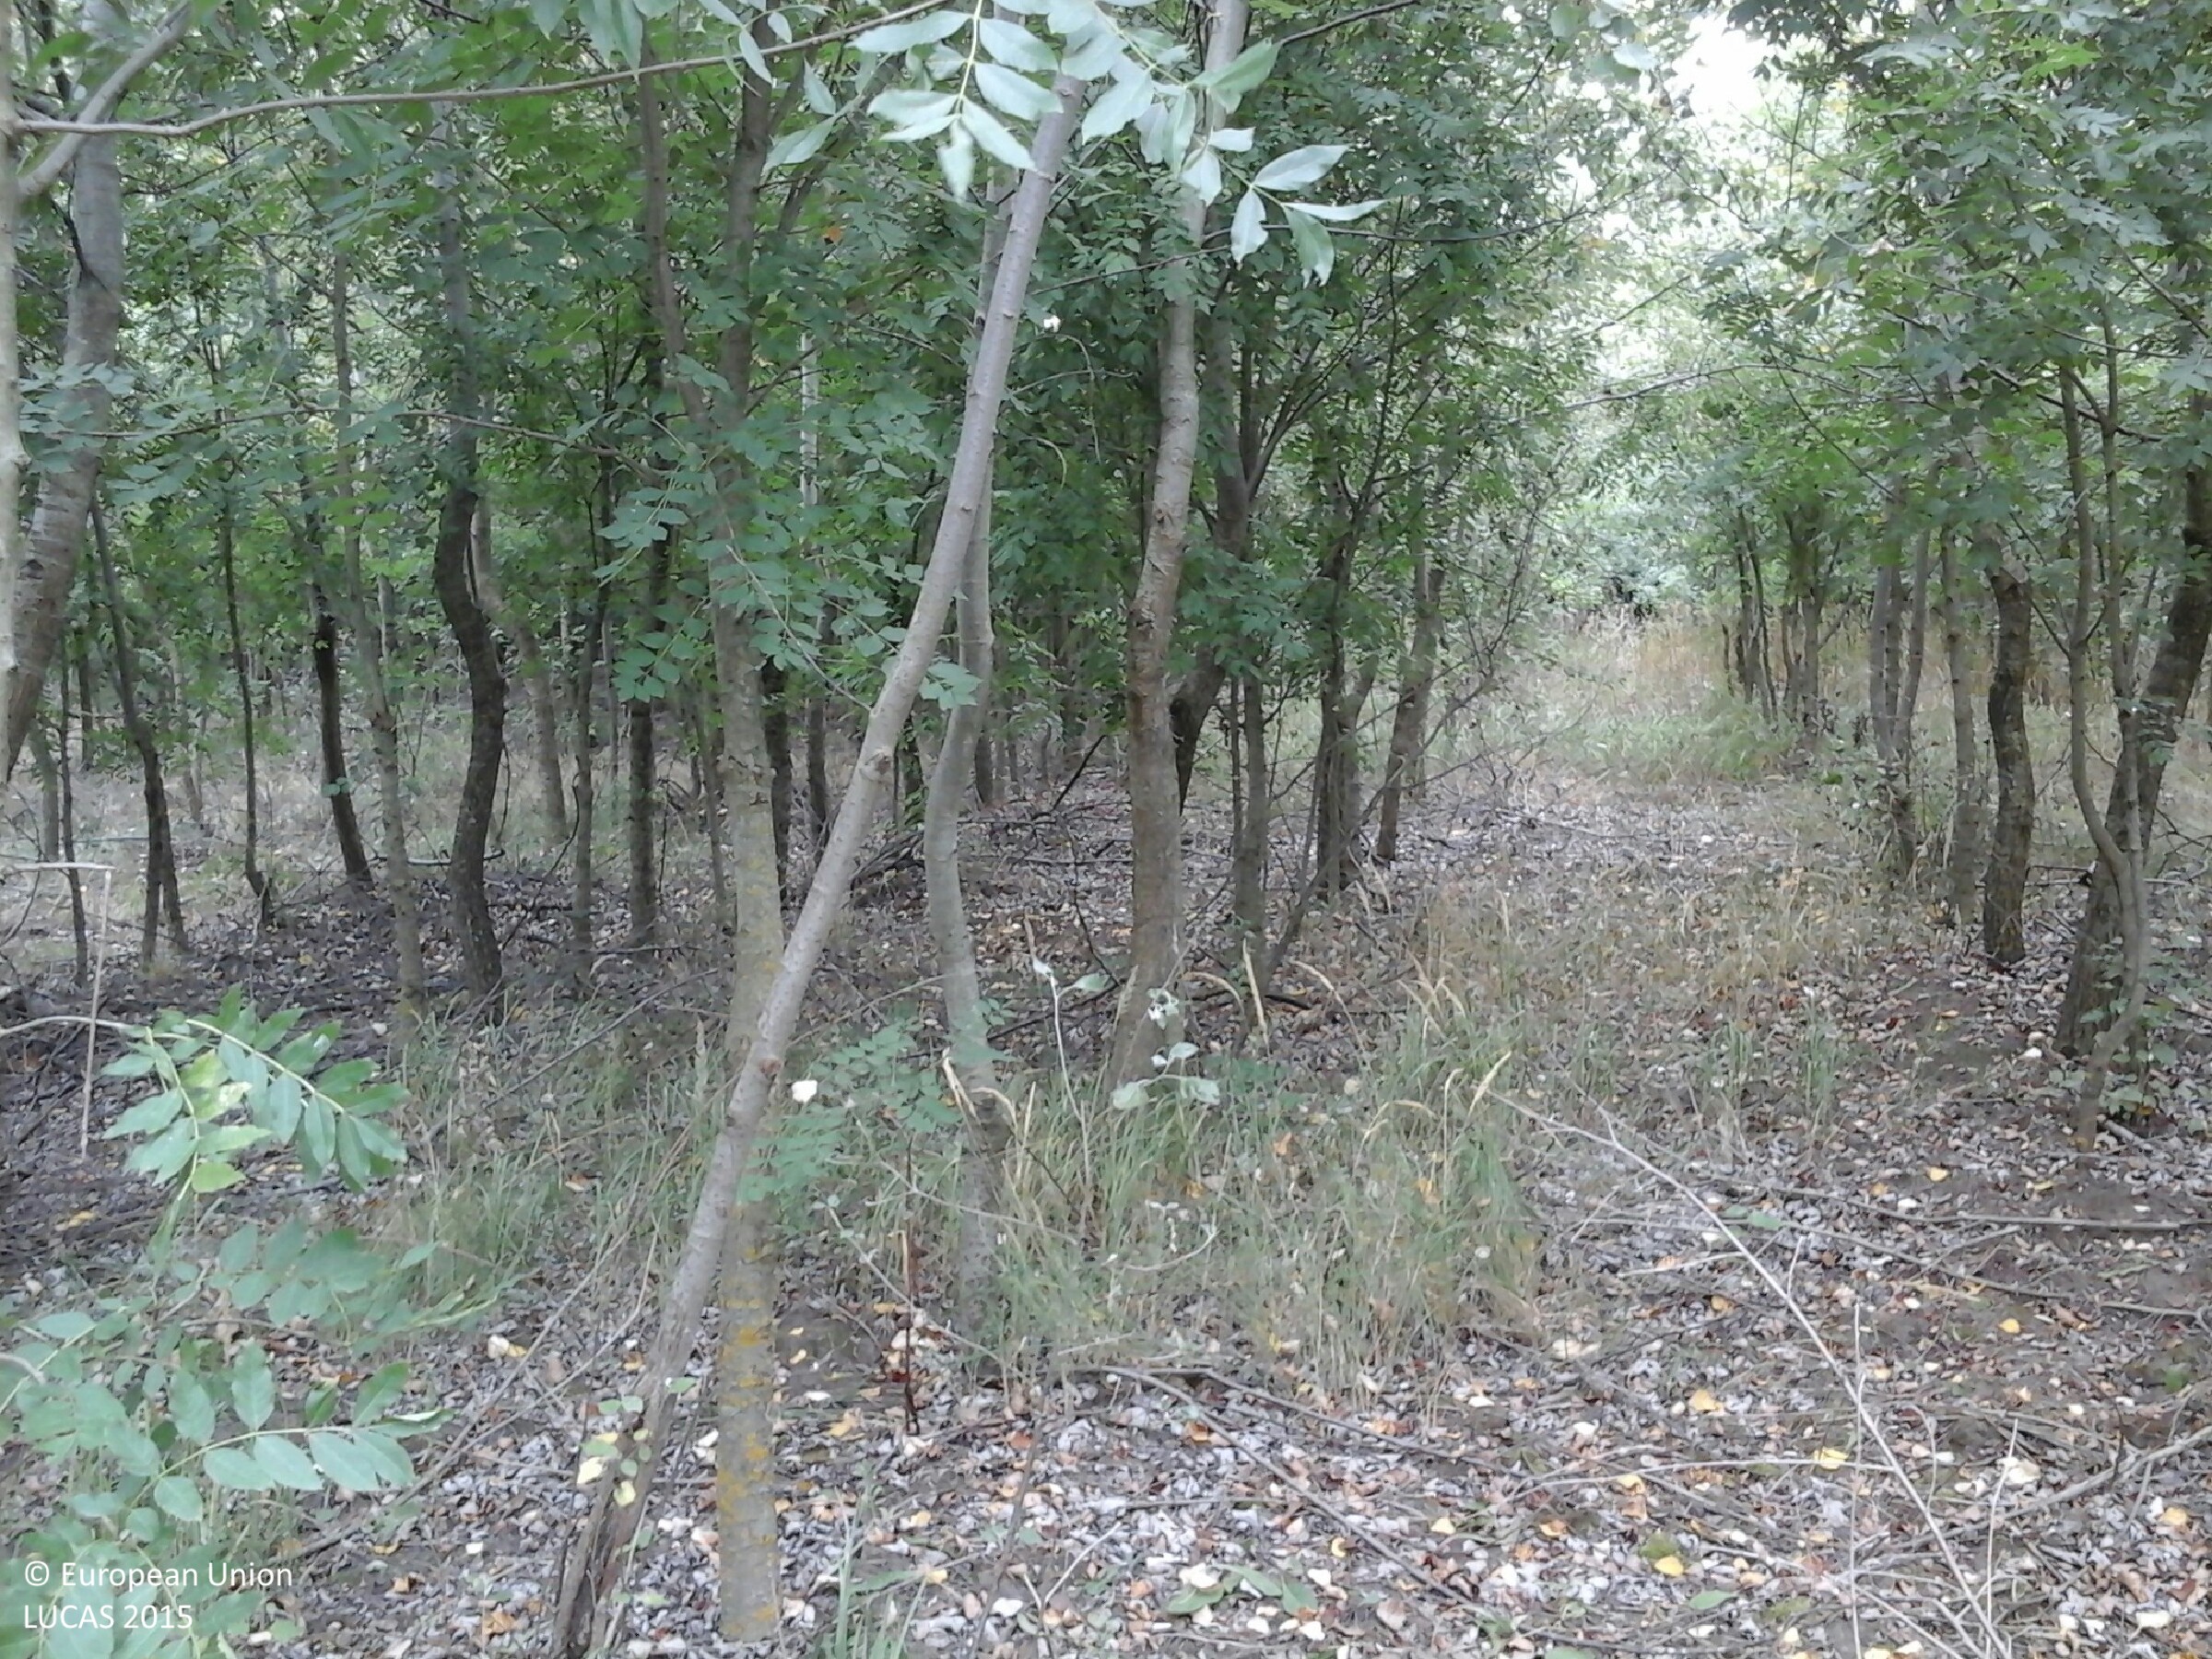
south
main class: Woodland
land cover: Broadleaved woodland
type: mesophytic deciduous forest
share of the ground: > 75 %
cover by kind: broadleaved forest trees 75 %, herbaceous plants 25 %
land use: Forestry
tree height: > 5 m
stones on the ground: < 10 %
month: July
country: HU
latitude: 47.4132
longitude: 20.6751
